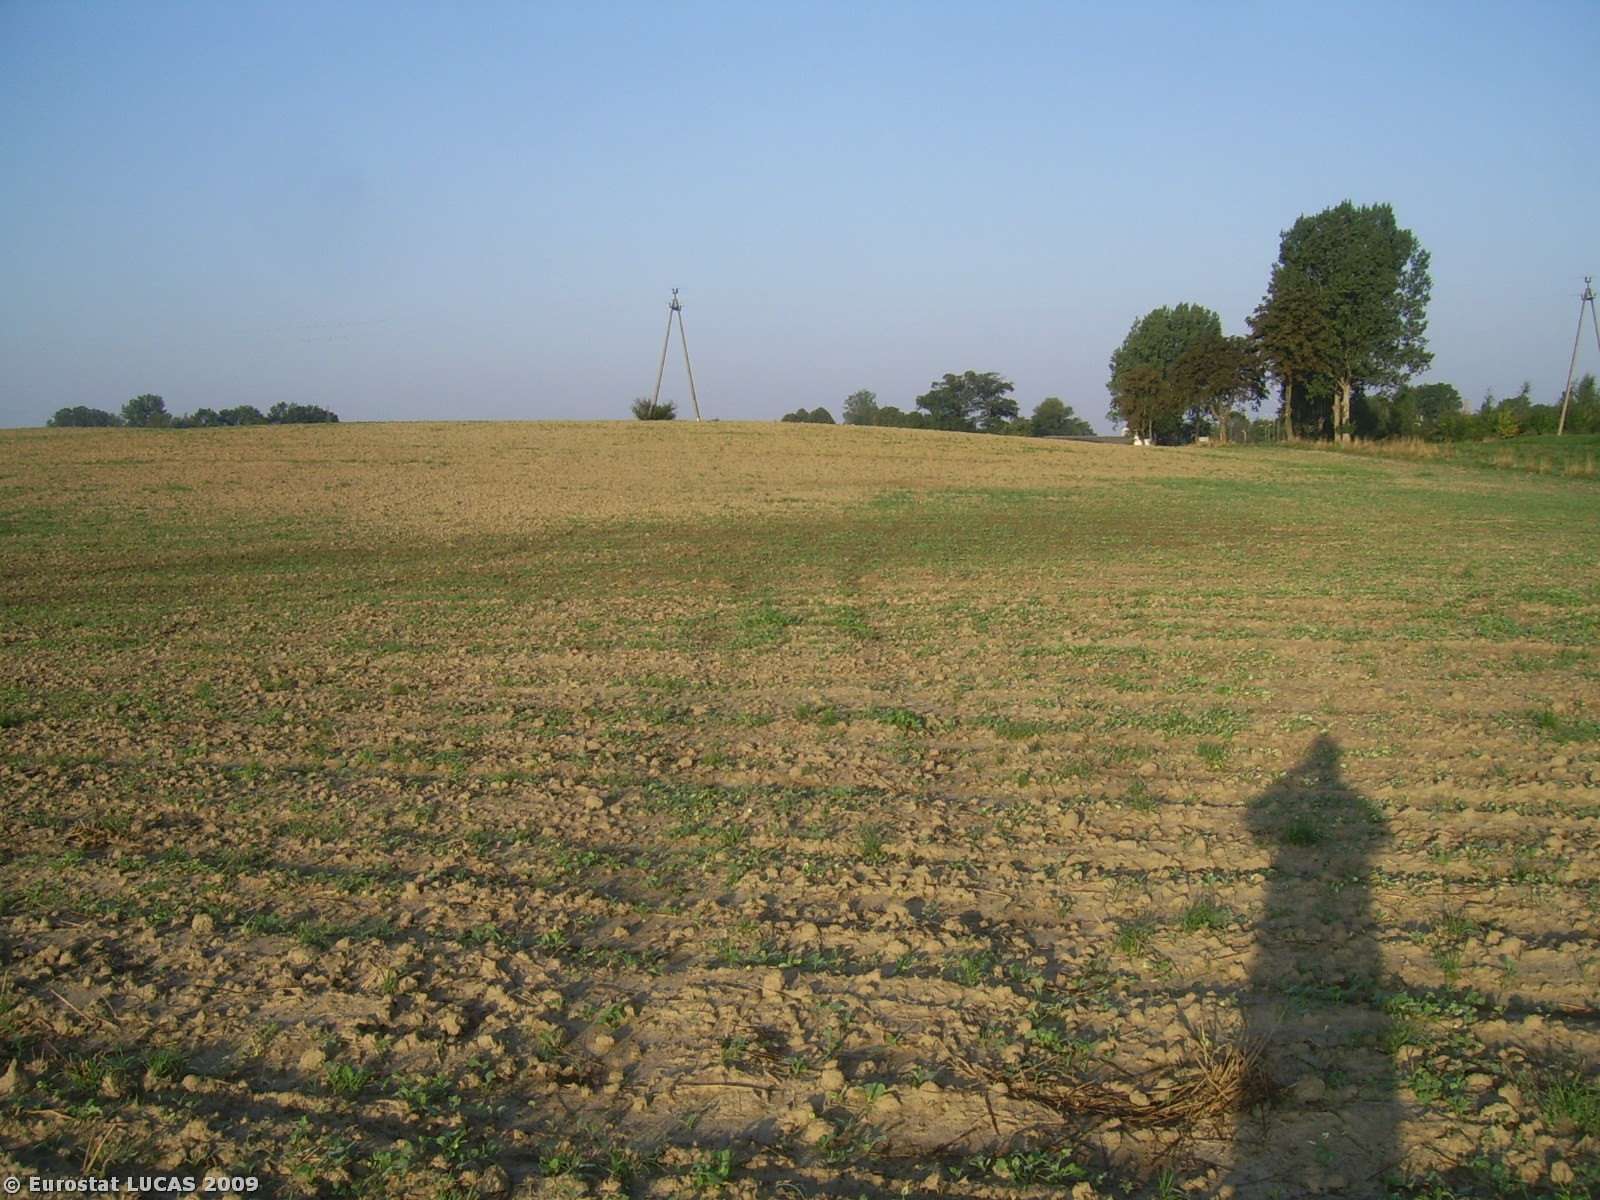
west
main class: Cropland
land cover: Rye
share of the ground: < 10 %
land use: Agriculture (excluding fallow land and kitchen gardens)
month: September
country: PL
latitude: 54.2086
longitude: 15.9992
